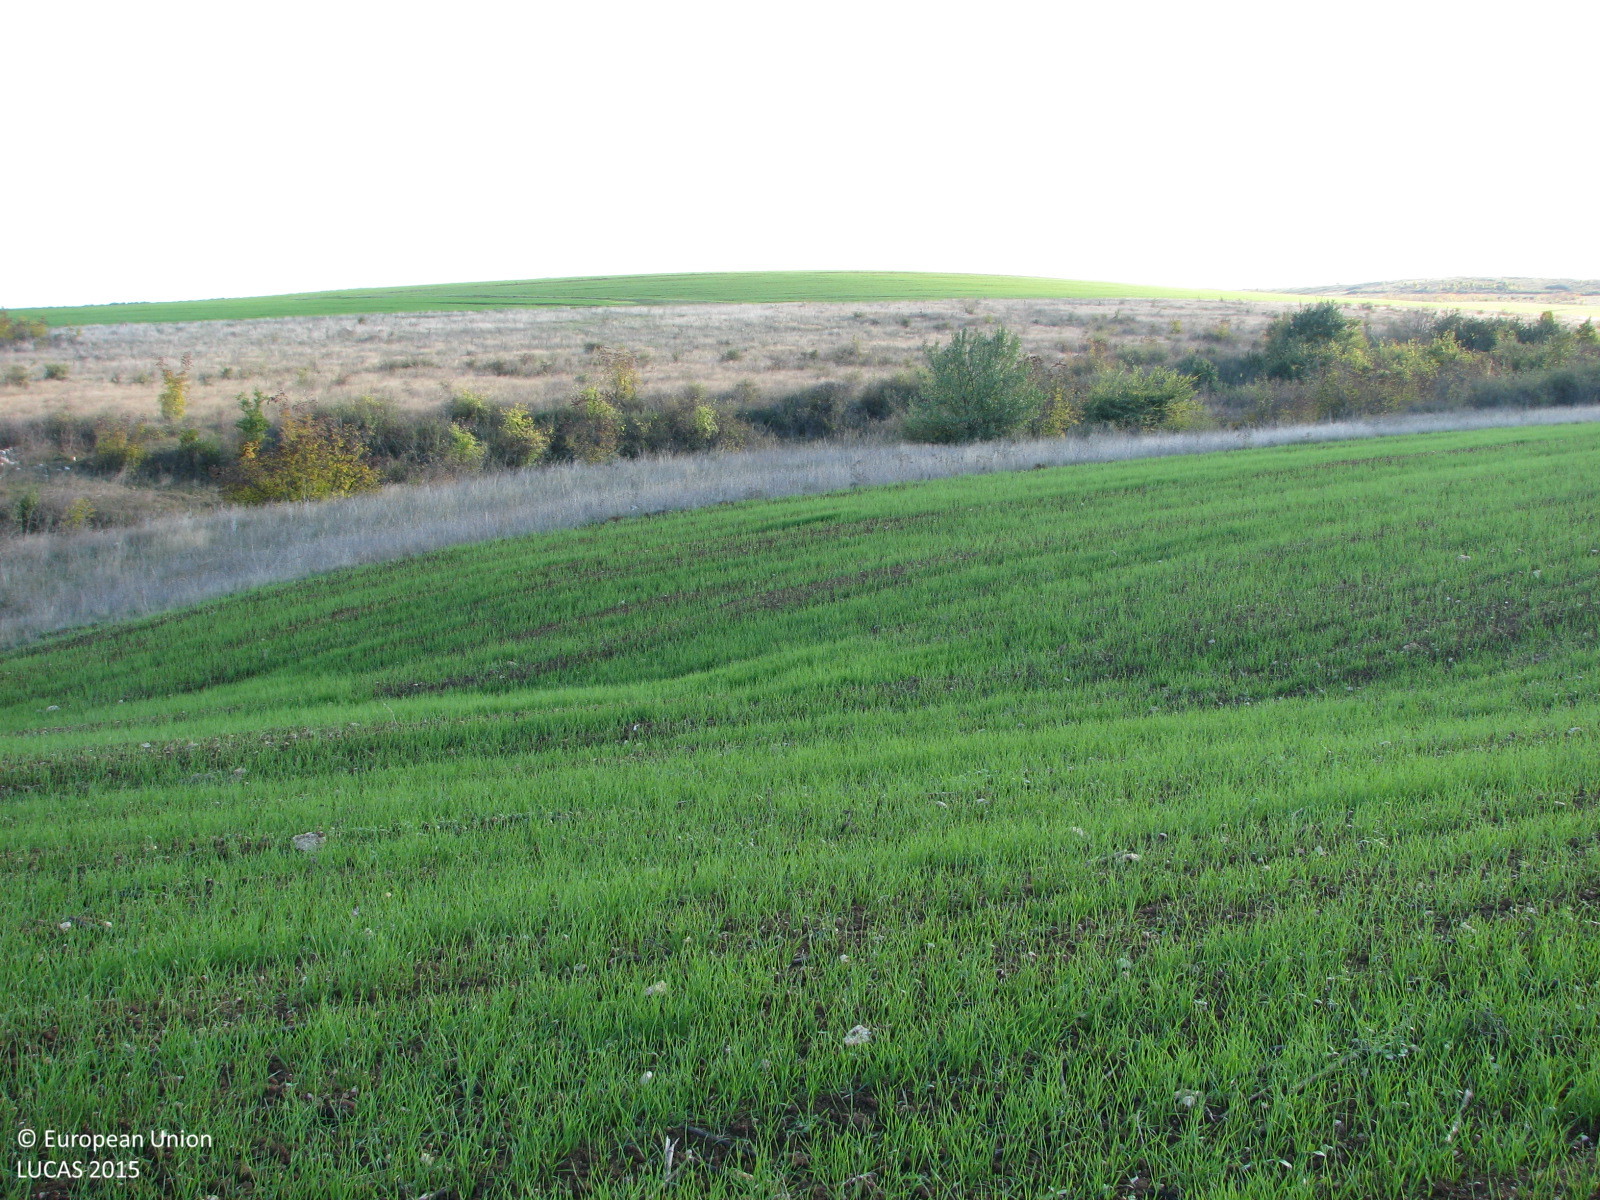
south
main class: Cropland
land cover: Common wheat
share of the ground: 50 - 75 %
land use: Agriculture (excluding fallow land and kitchen gardens)
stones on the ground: < 10 %
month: October
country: BG
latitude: 42.1020
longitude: 26.3722
